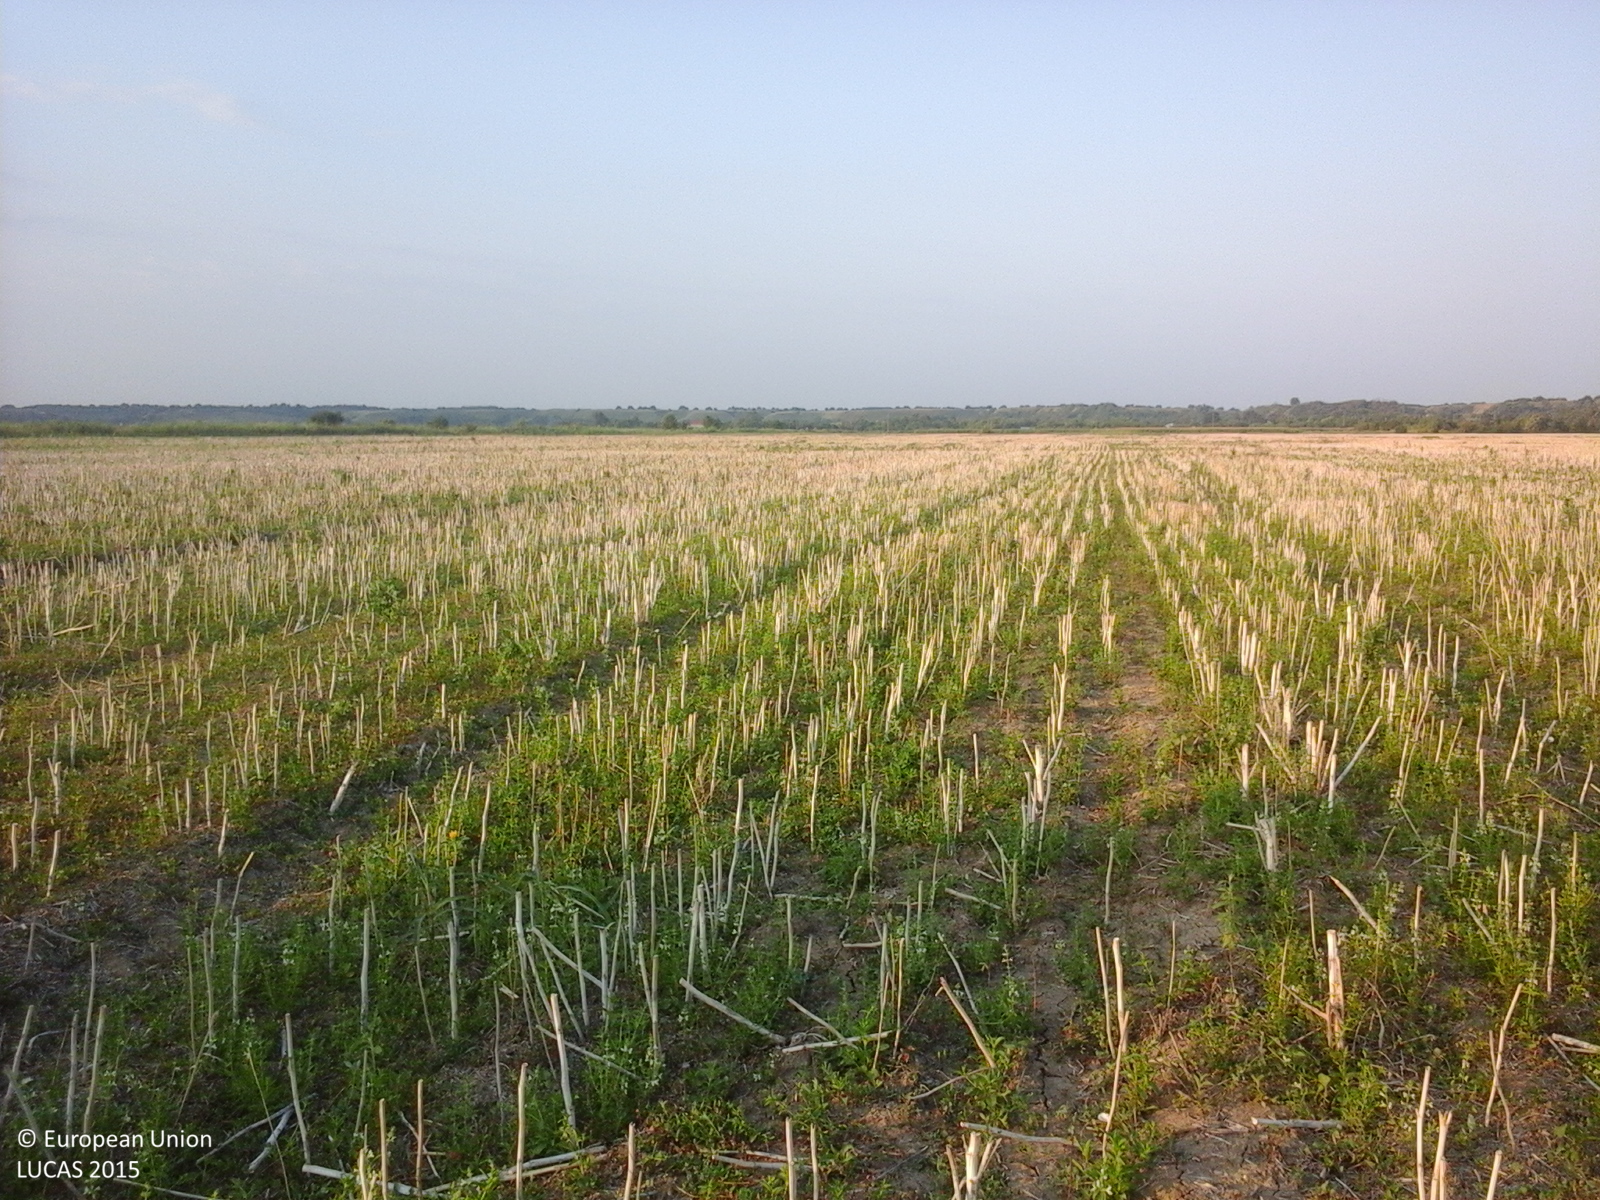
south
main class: Cropland
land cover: Rape and turnip rape
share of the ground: 10 - 25 %
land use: Agriculture (excluding fallow land and kitchen gardens)
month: July
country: RO
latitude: 44.5497
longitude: 27.1392
